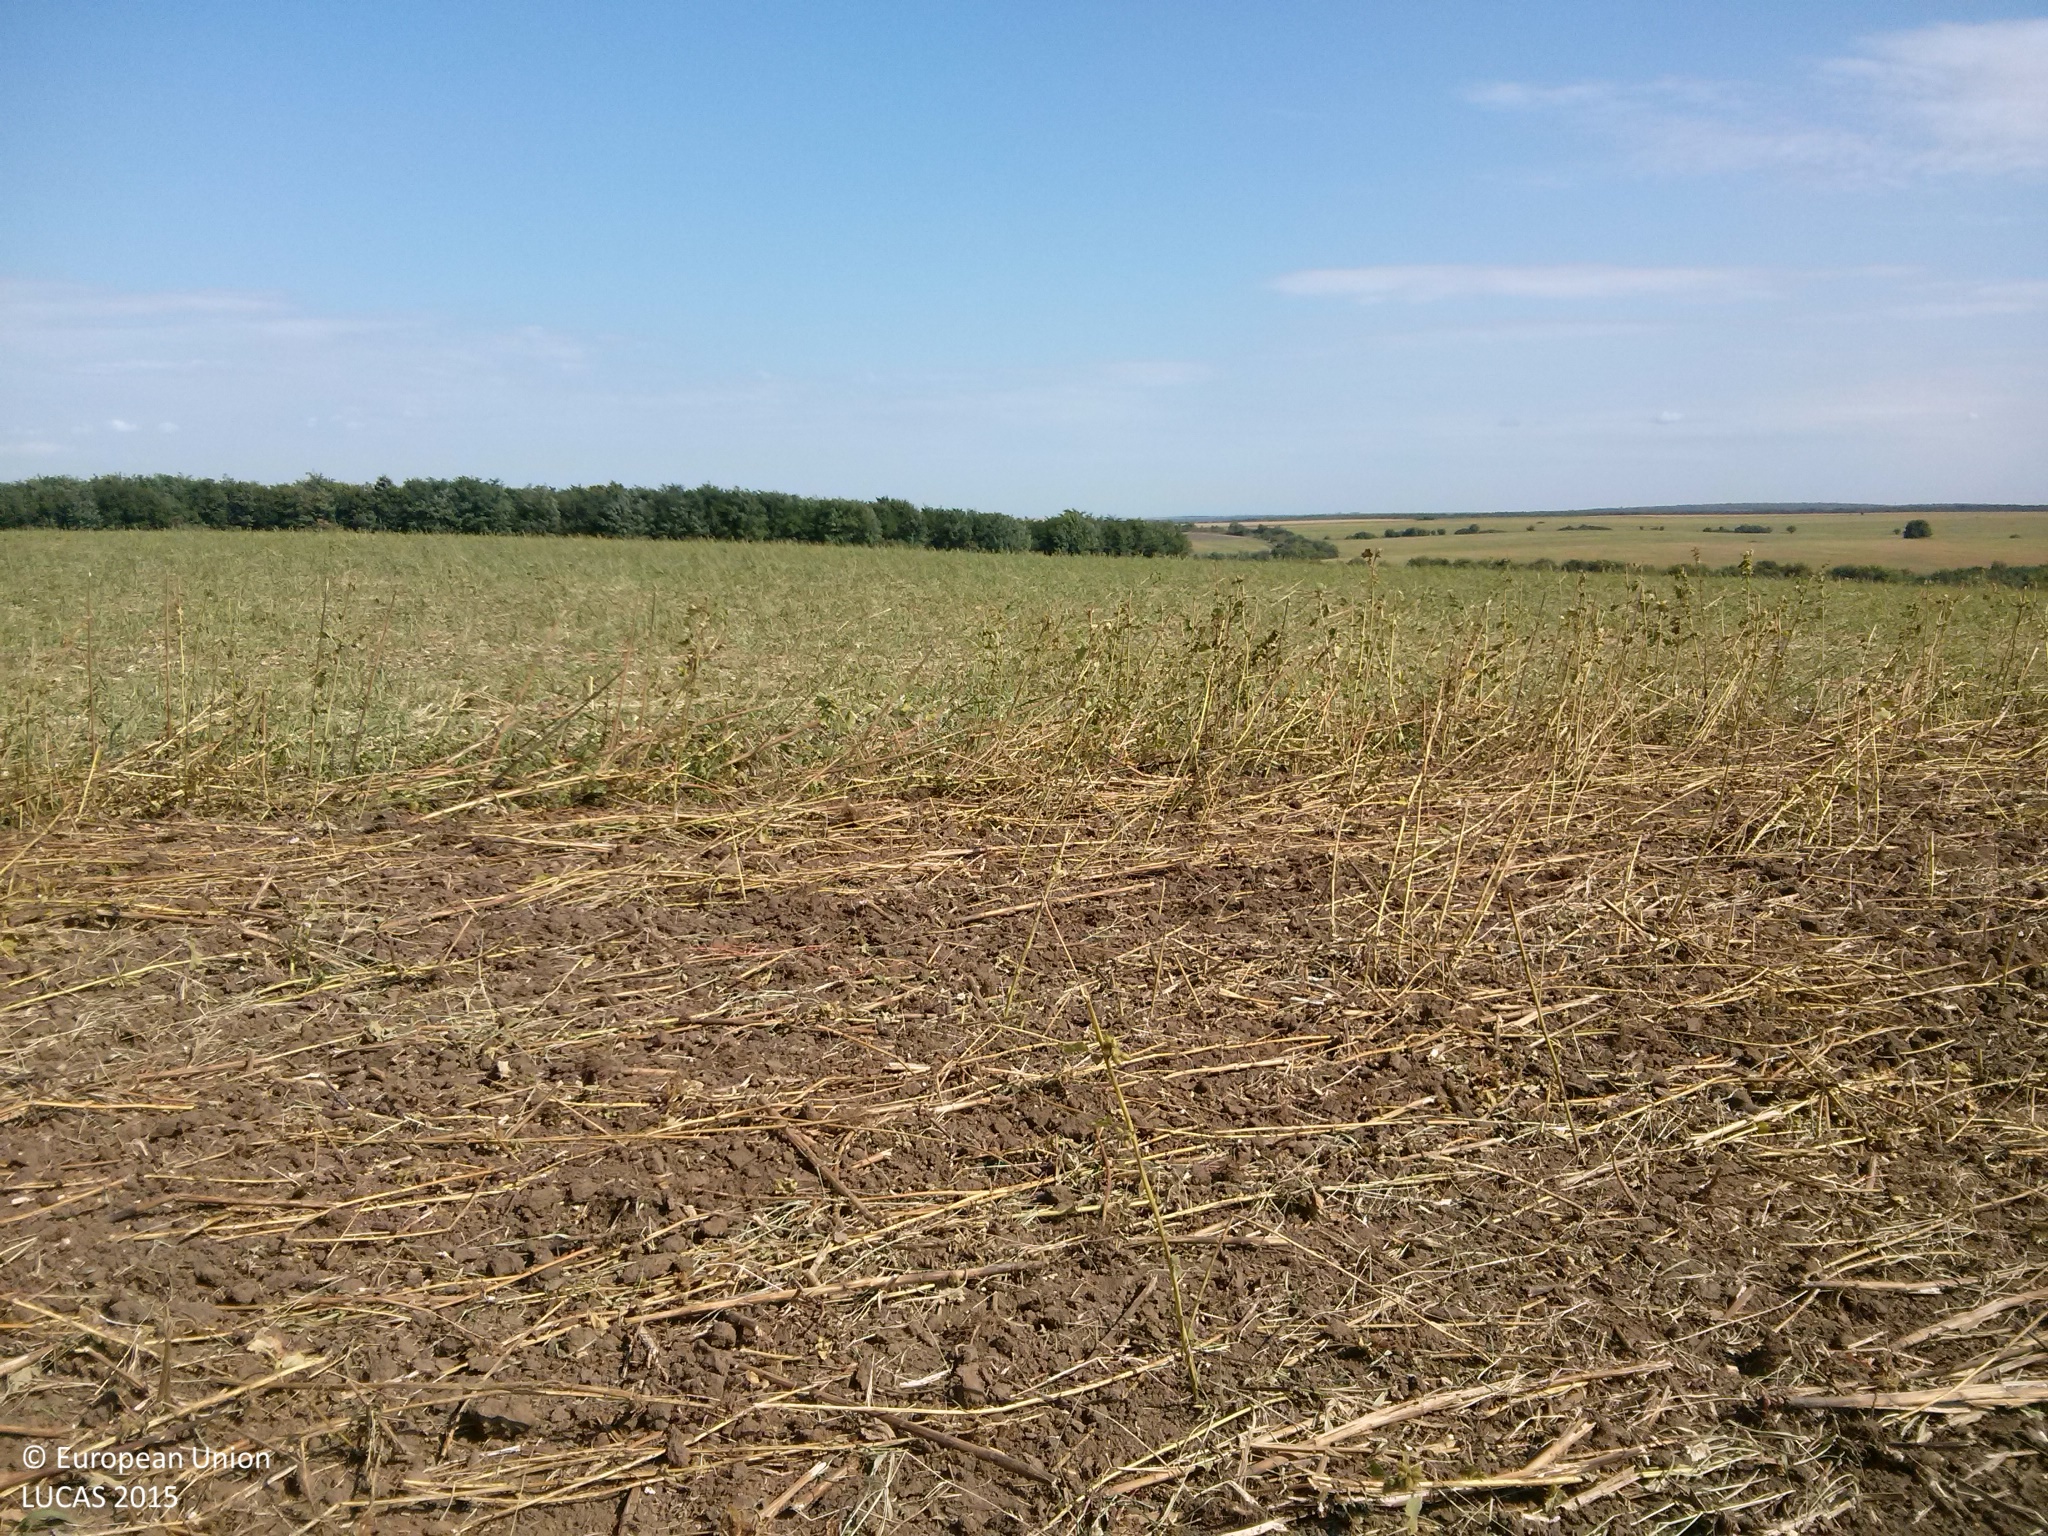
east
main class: Cropland
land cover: Sunflower
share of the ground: 10 - 25 %
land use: Agriculture (excluding fallow land and kitchen gardens)
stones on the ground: < 10 %
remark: Harvested field
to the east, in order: Sunflower; Shruby margins; Sunflower
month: September
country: BG
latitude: 43.8630
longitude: 26.3931
